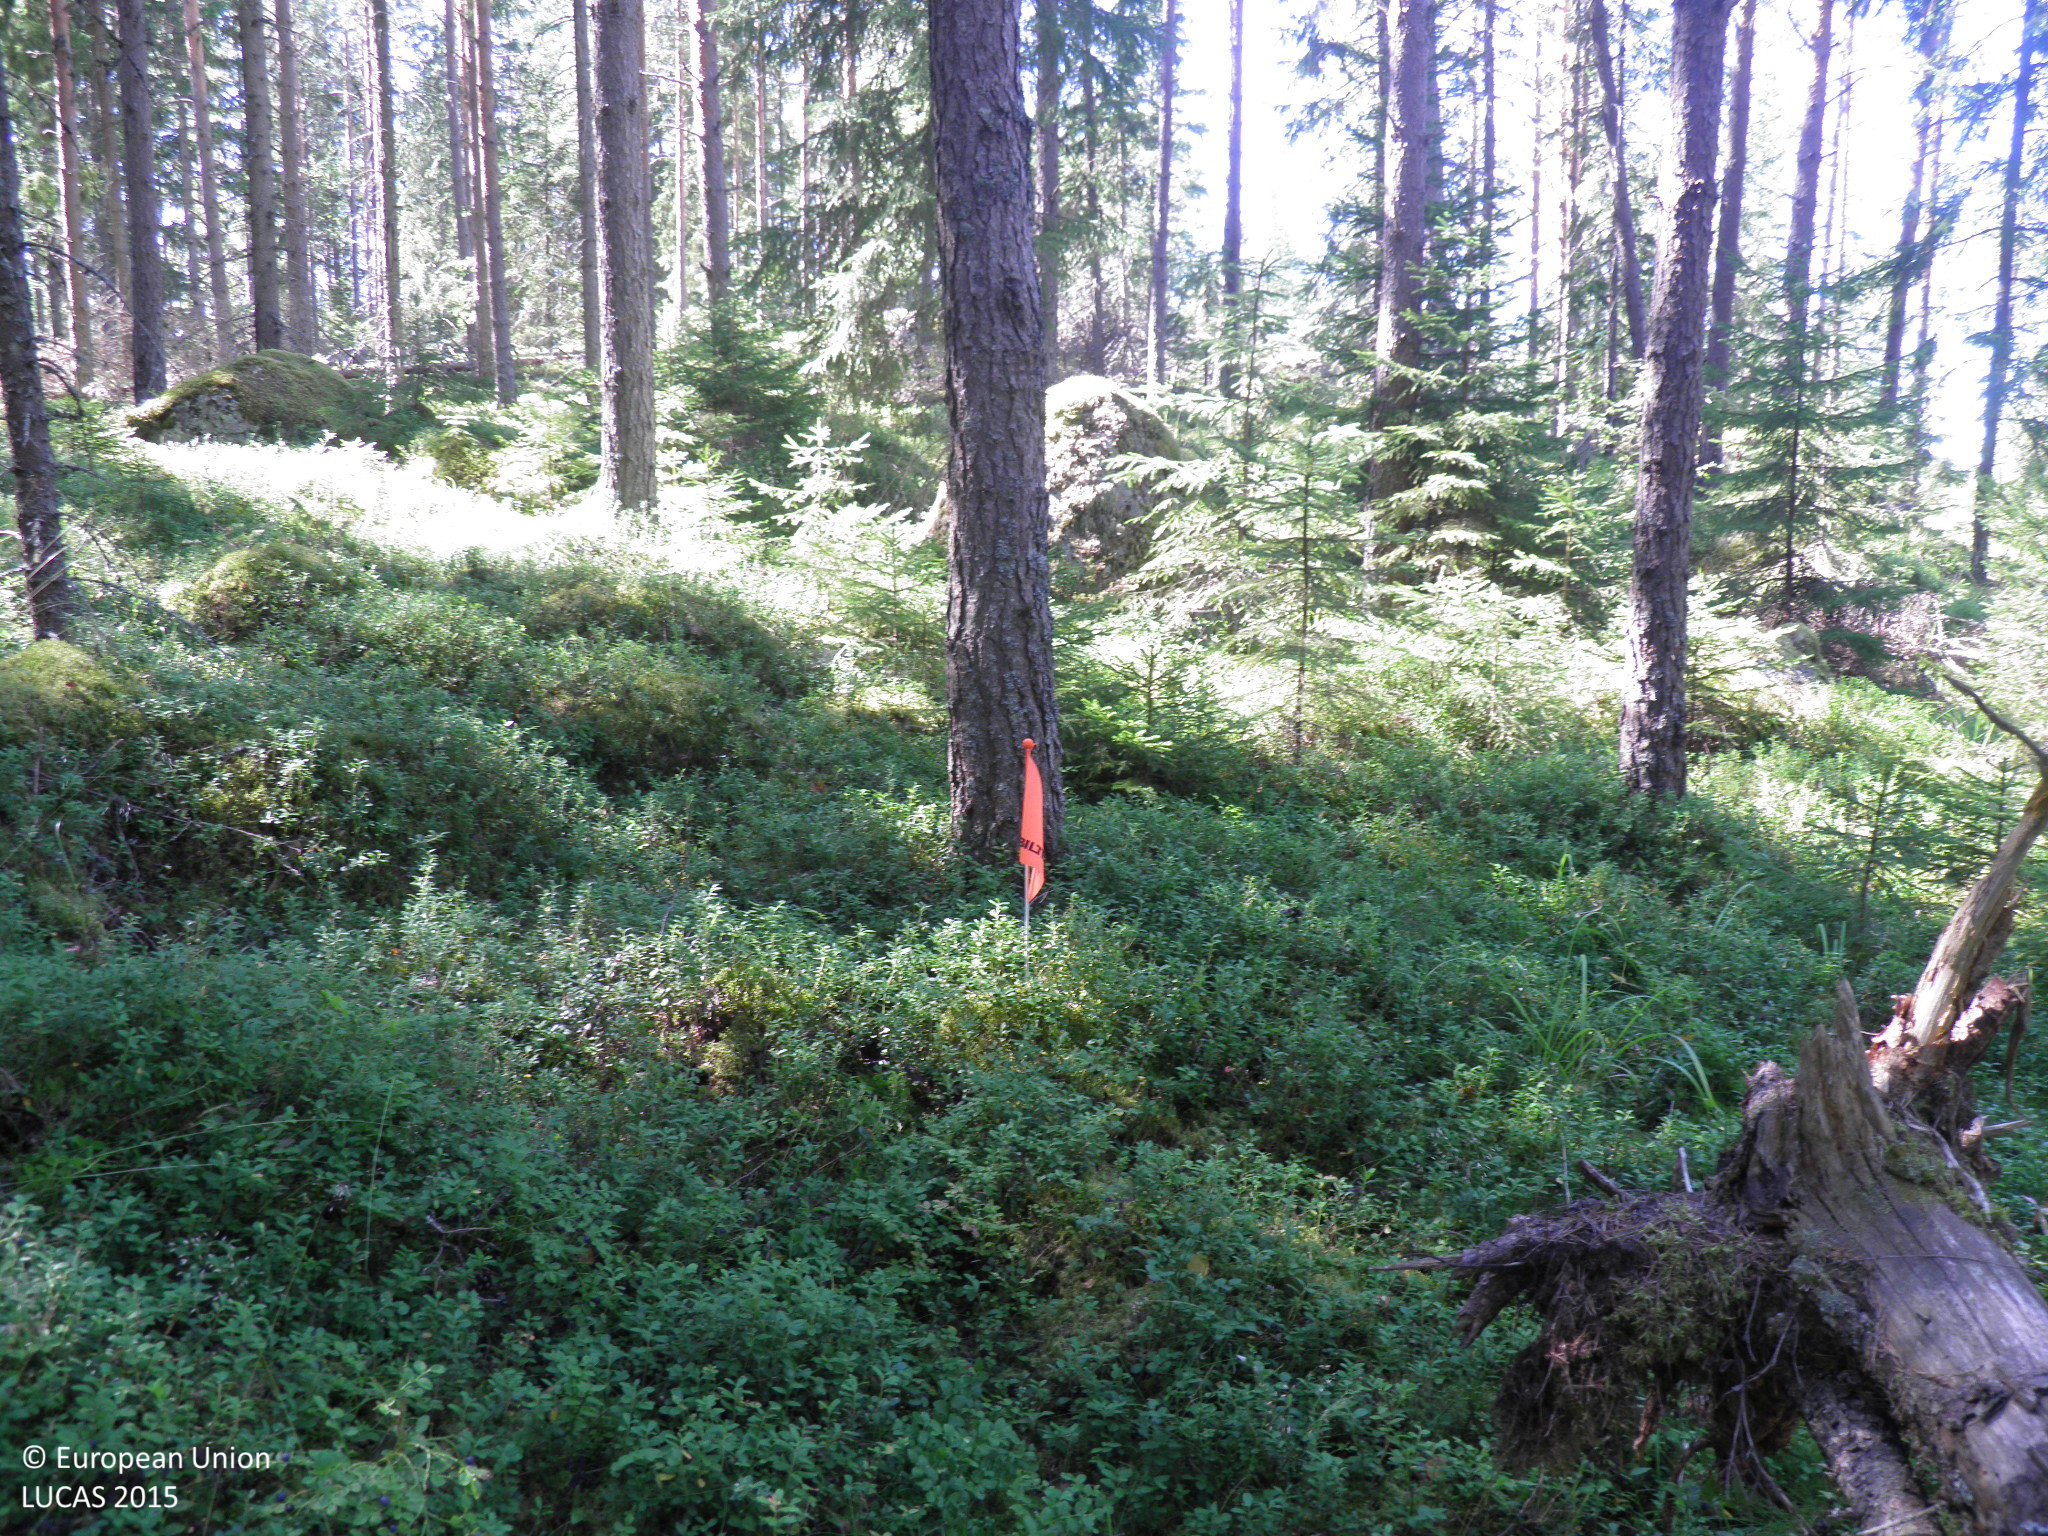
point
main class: Woodland
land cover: Other coniferous woodland
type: hemiboreal forest and nemoral coniferous forest and mixed broadleaved-coniferous forest
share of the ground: 50 - 75 %
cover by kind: coniferous forest trees 50 %, shrubs 20 %, herbaceous plants 20 %, broadleaved forest trees 10 %
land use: Forestry
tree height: > 5 m
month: August
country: FI
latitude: 60.7570
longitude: 22.0453
